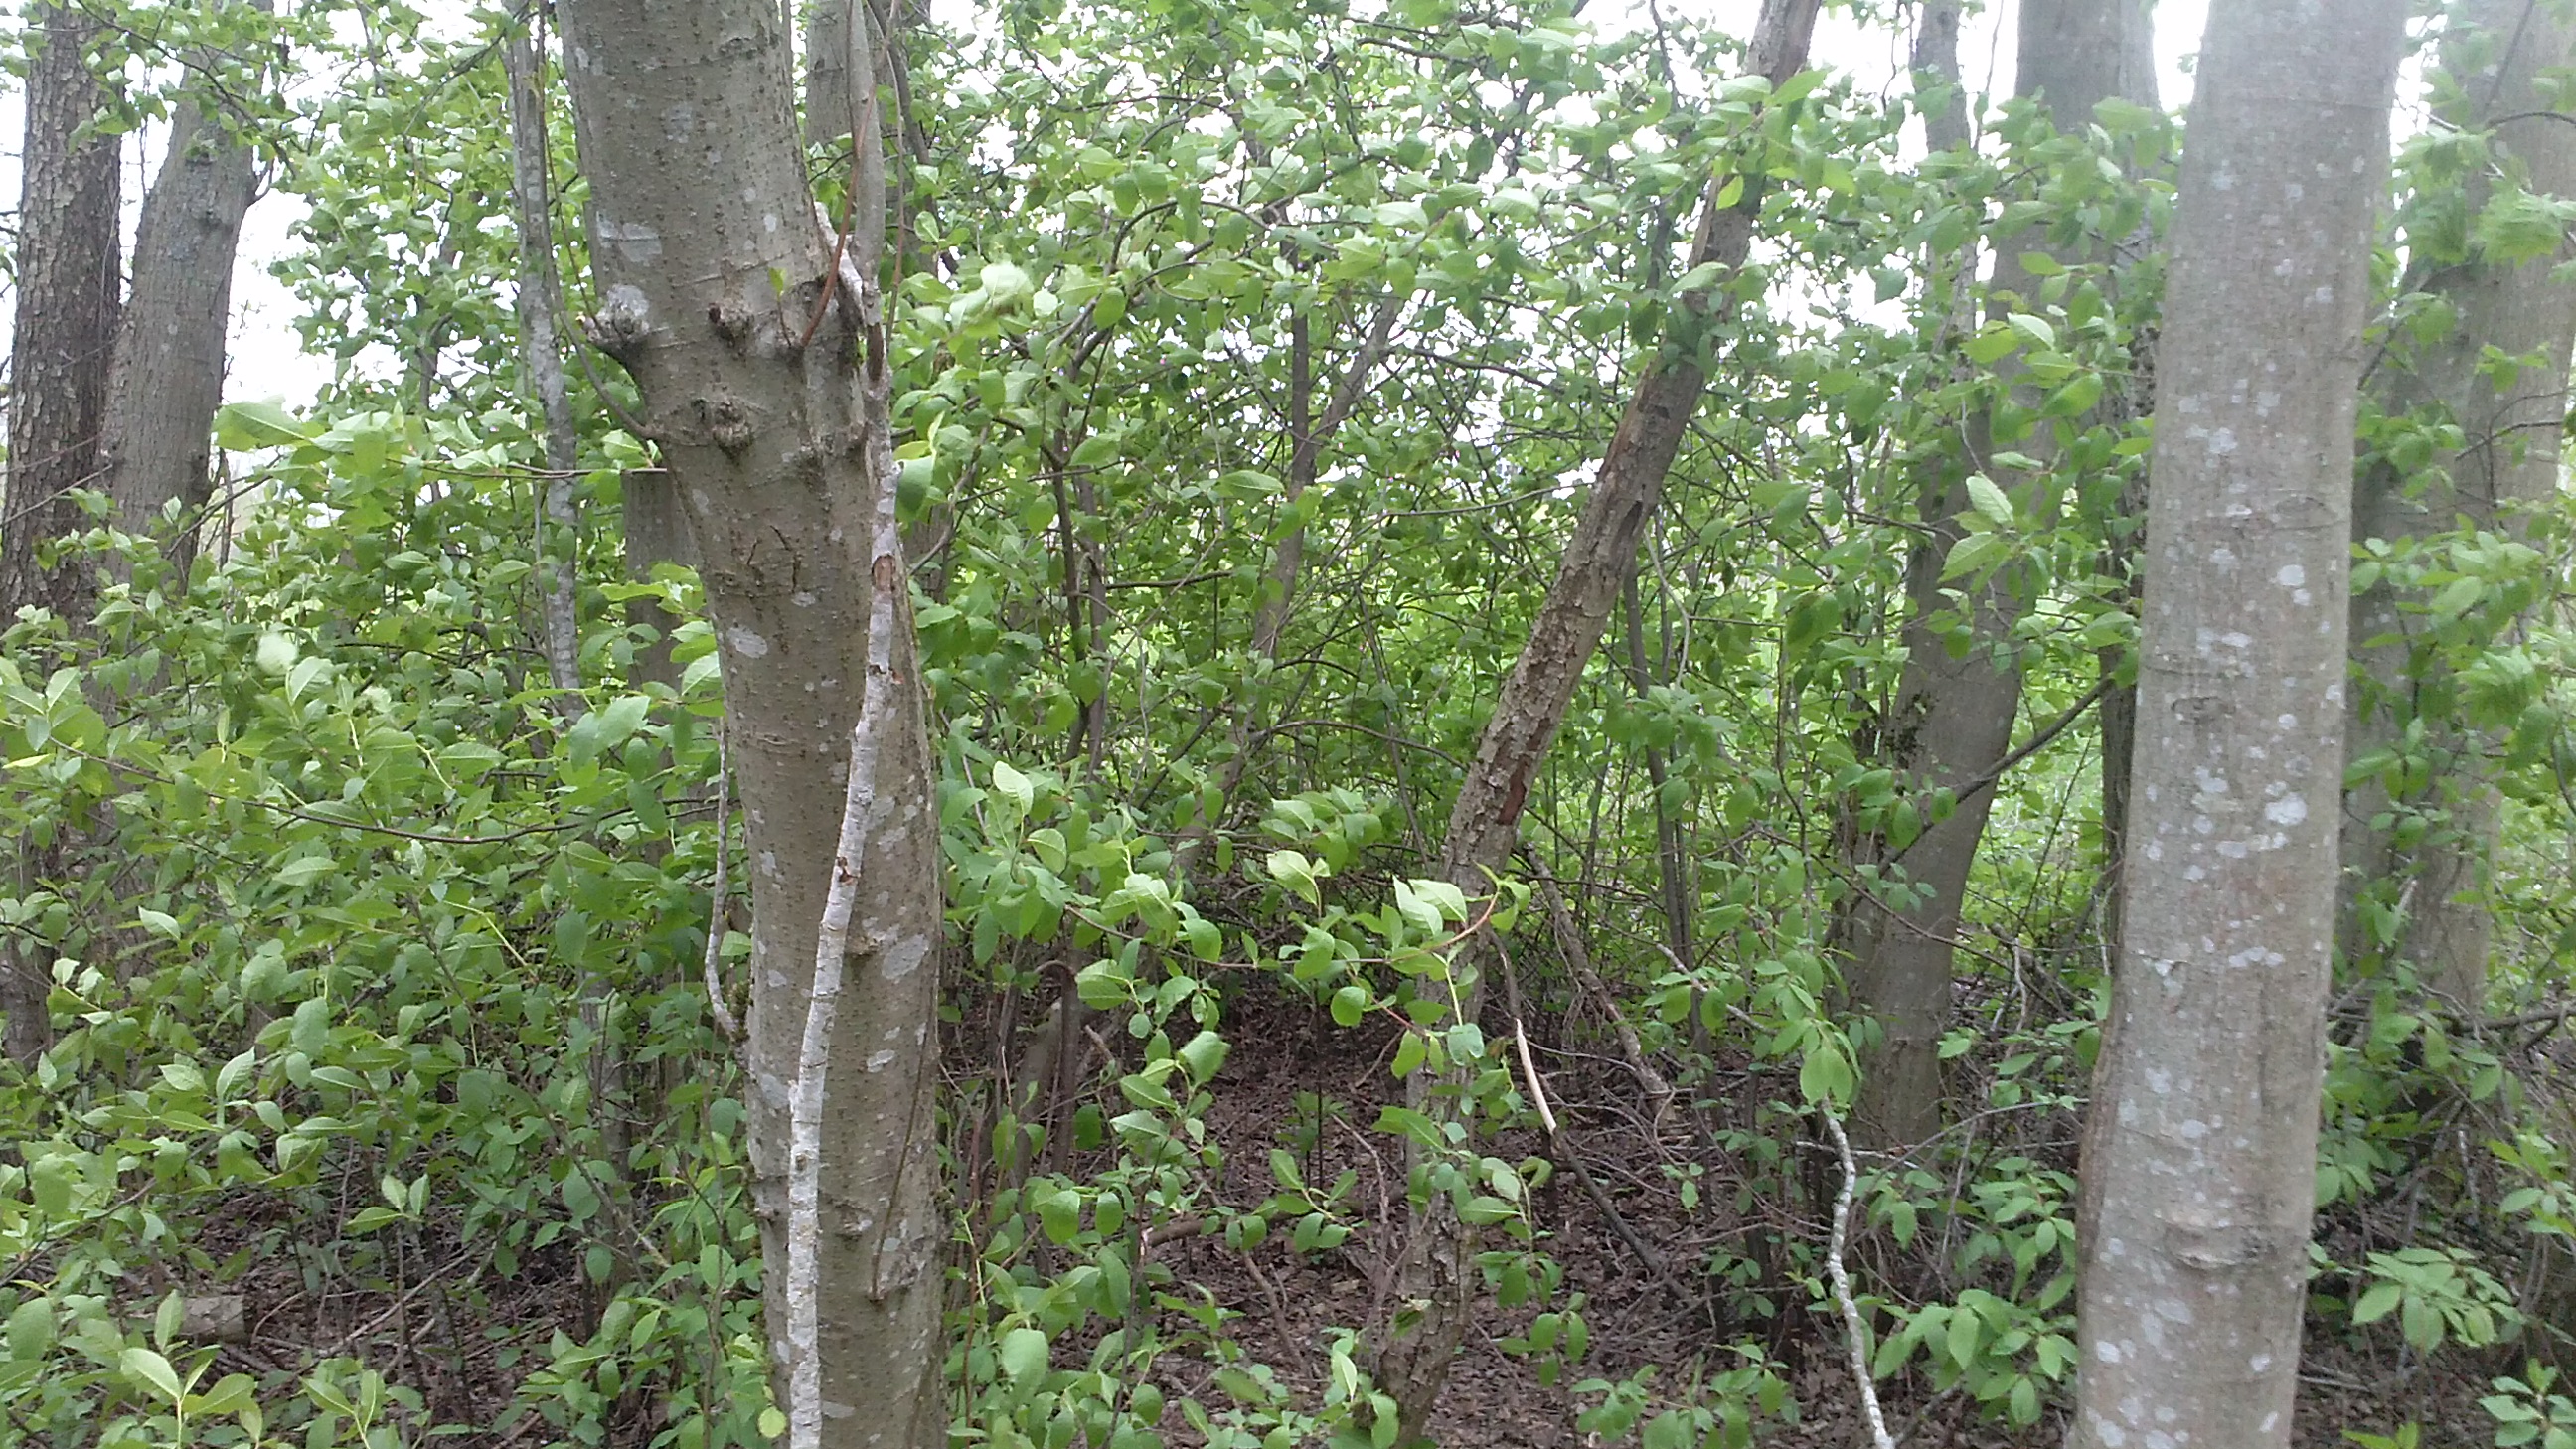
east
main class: Woodland
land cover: Broadleaved woodland
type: non-riverine alder, birch or aspen forest
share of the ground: > 75 %
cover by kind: broadleaved forest trees 90 %, shrubs 10 %
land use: Forestry
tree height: > 5 m
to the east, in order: Broadleaved woodland; Grassland without tree/shrub cover; Broadleaved woodland; Grassland without tree/shrub cover; Apple fruit; Electric lines; Grass margins; Paved roads, cycling and walking lanes; Apple fruit; Paved roads, cycling and walking lanes
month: May
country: LV
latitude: 55.9706
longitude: 27.0716
